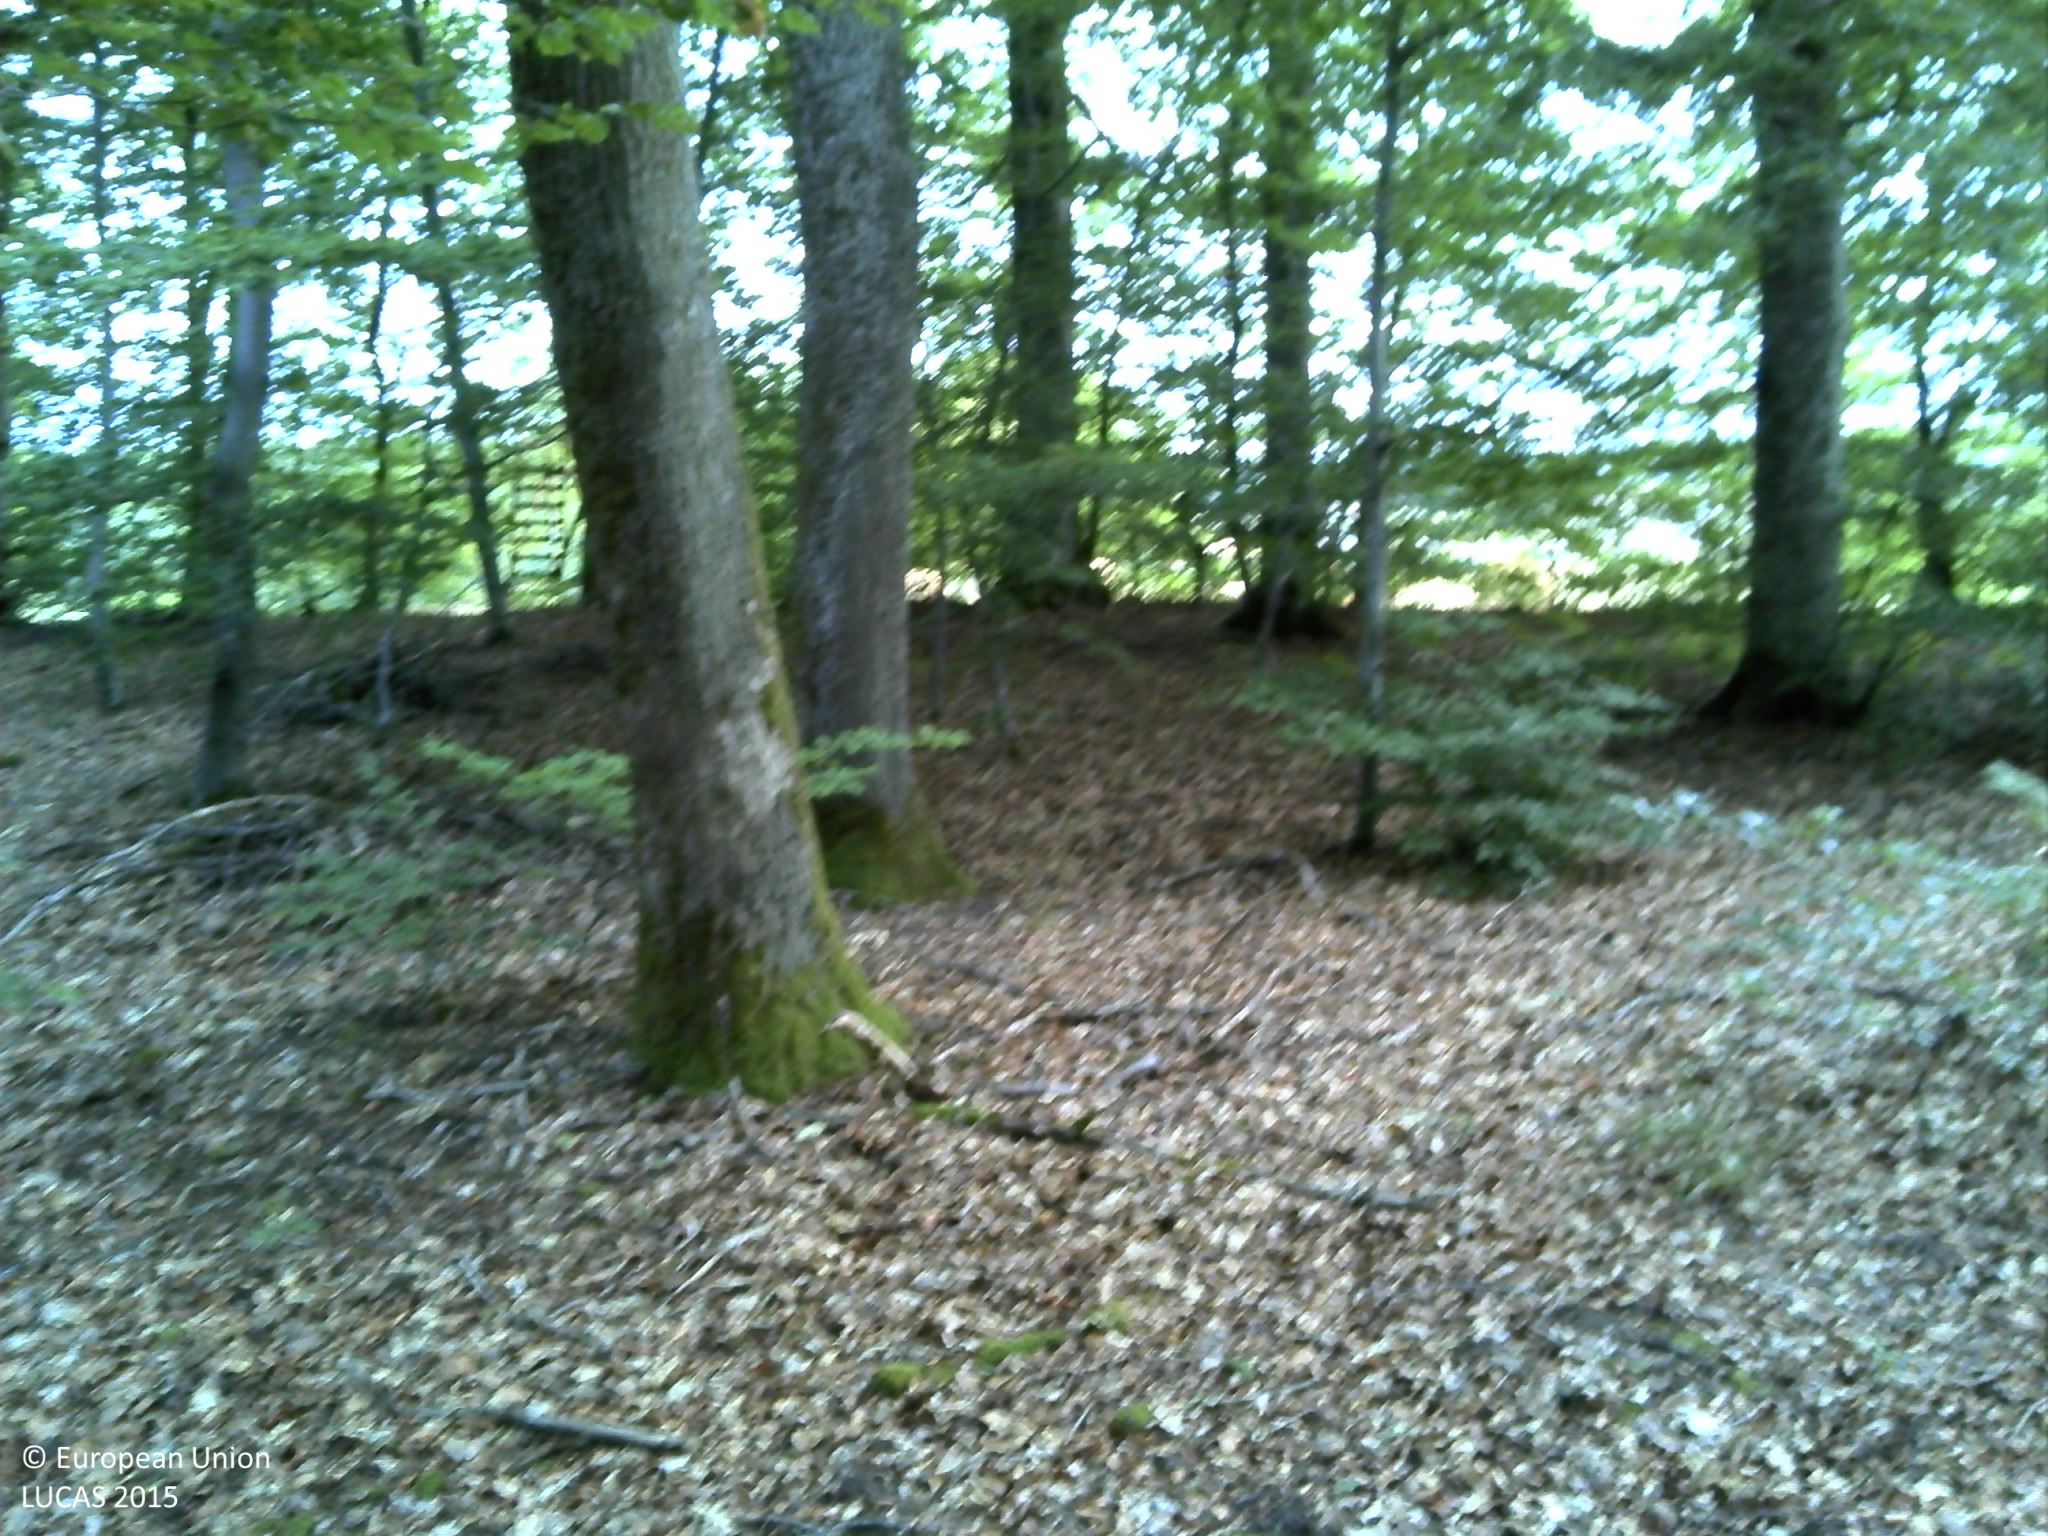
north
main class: Woodland
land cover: Broadleaved woodland
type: beech forest
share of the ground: > 75 %
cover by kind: broadleaved forest trees 80 %, unconsolidated bare surface 20 %
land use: Forestry
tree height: > 5 m
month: July
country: FR
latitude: 48.2505
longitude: 6.2699
